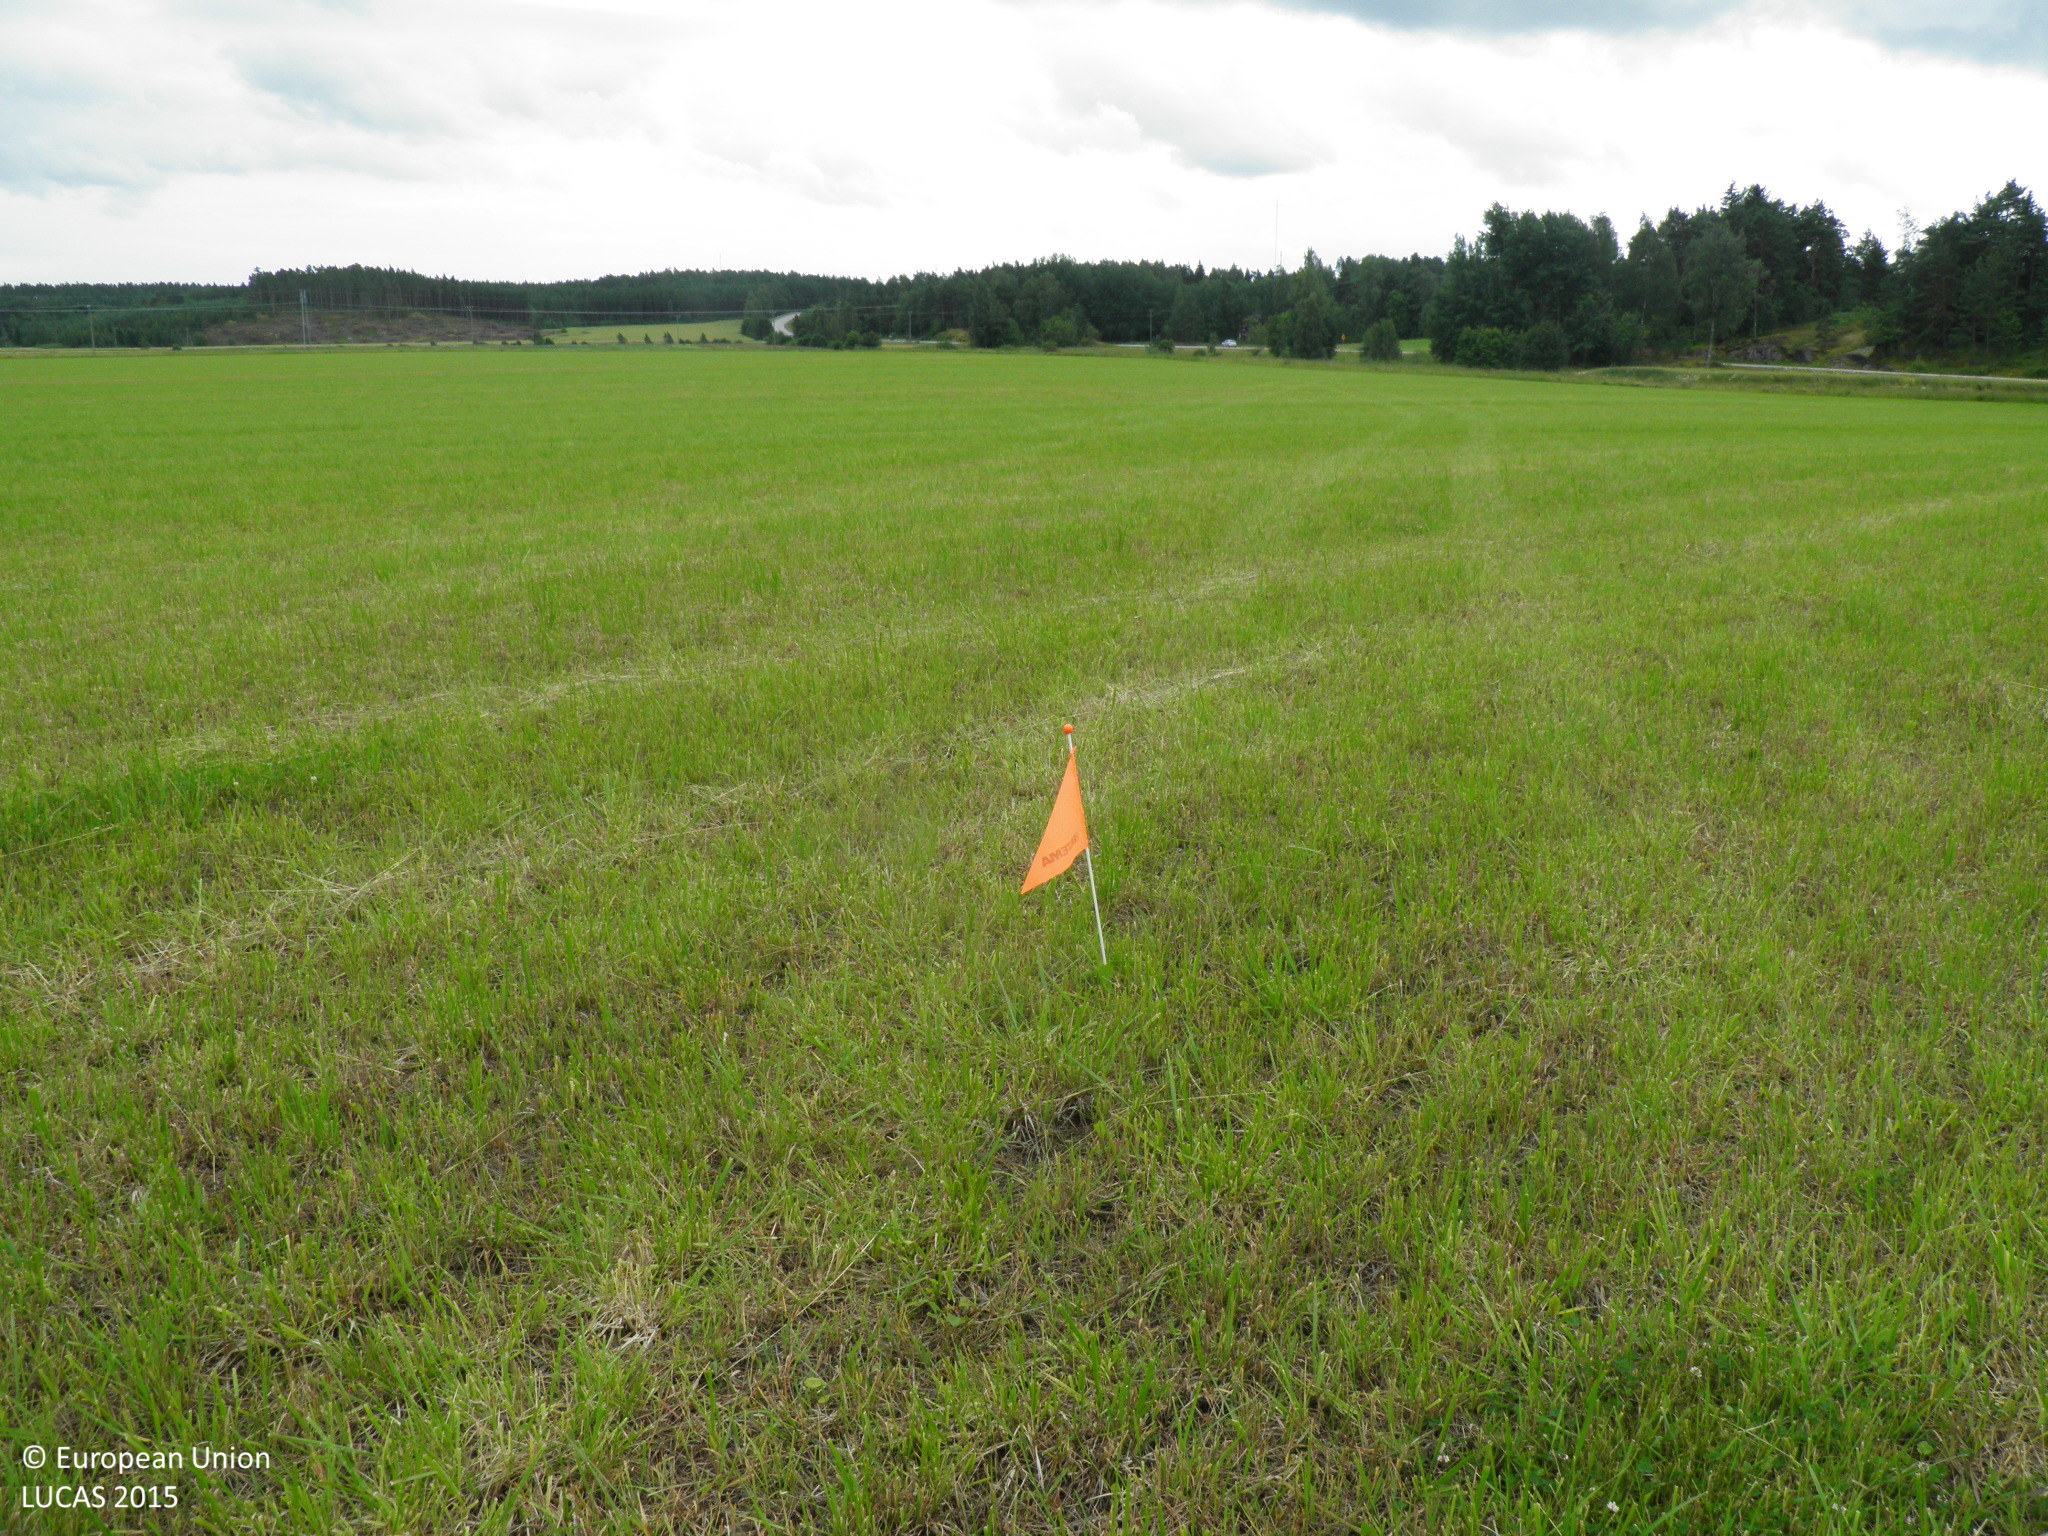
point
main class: Cropland
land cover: Temporary grasslands
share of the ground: > 75 %
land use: Agriculture (excluding fallow land and kitchen gardens)
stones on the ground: < 10 %
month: July
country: FI
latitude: 60.1868
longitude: 22.7159
